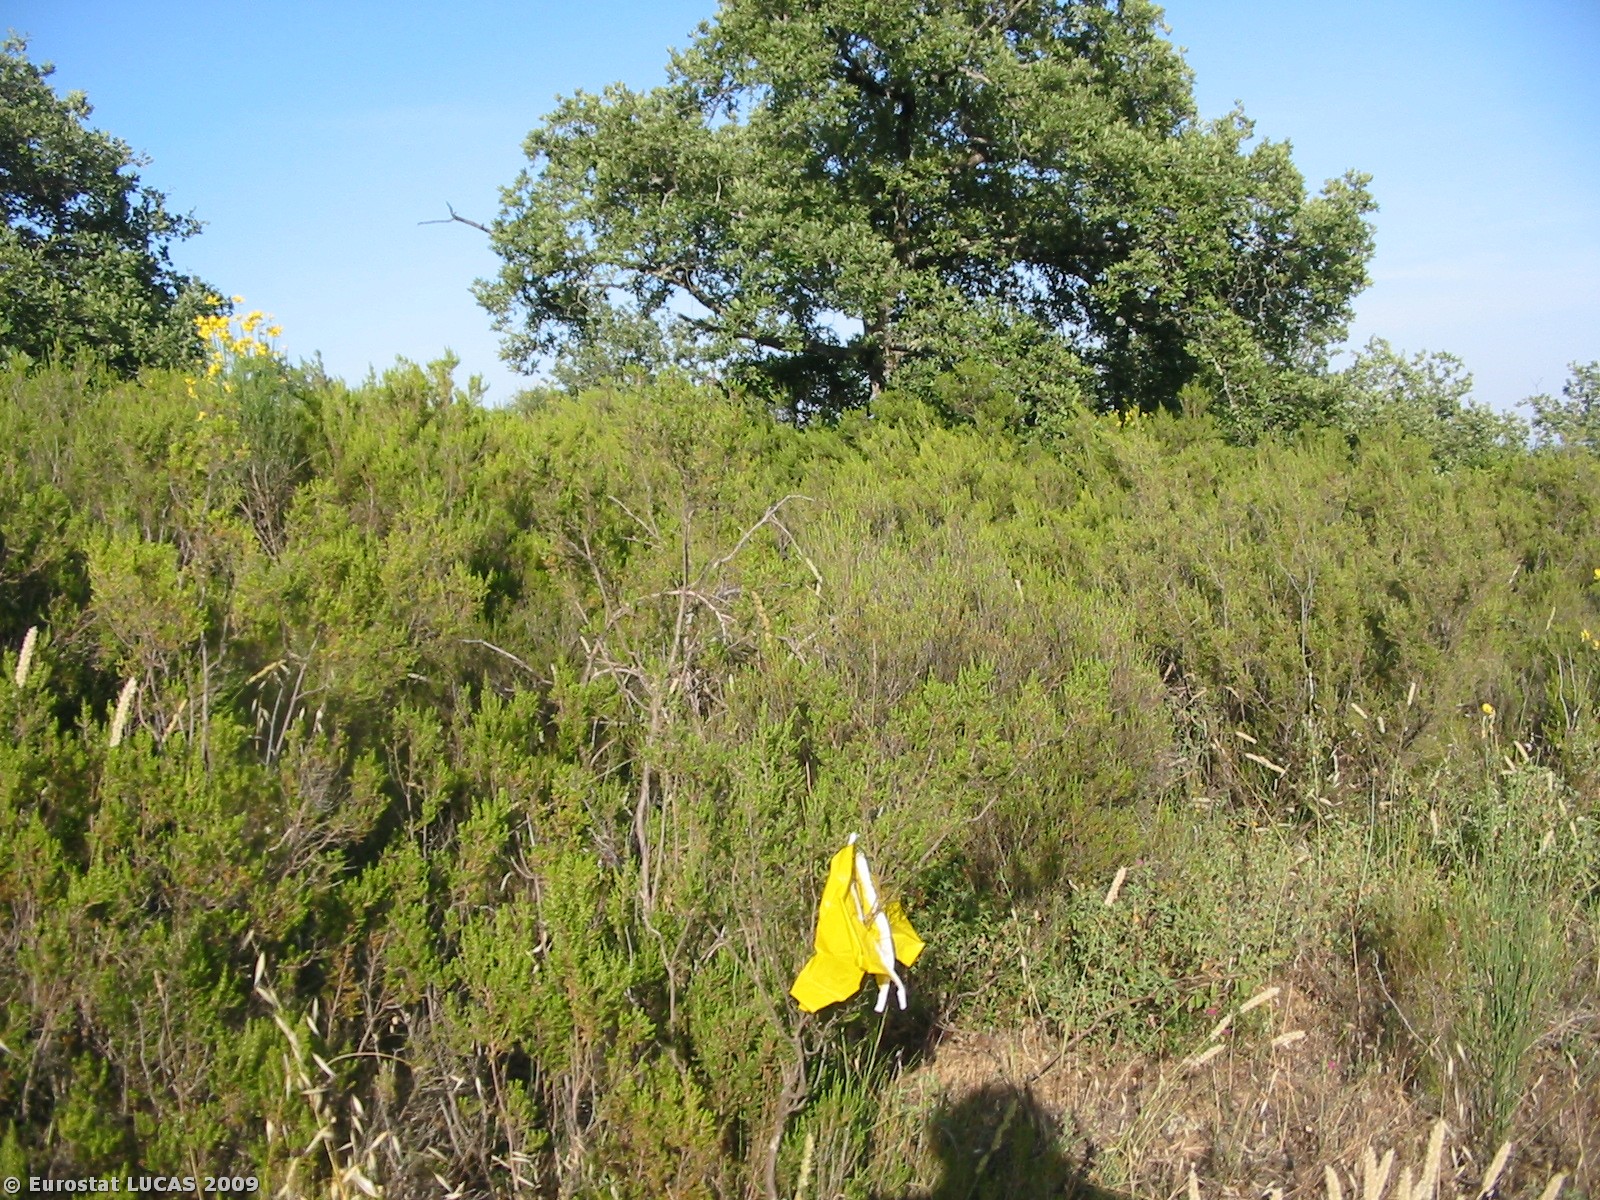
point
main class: Shrubland
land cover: Shrubland with sparse tree cover
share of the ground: > 75 %
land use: Unused
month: June
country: IT
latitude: 43.2721
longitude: 11.6831
